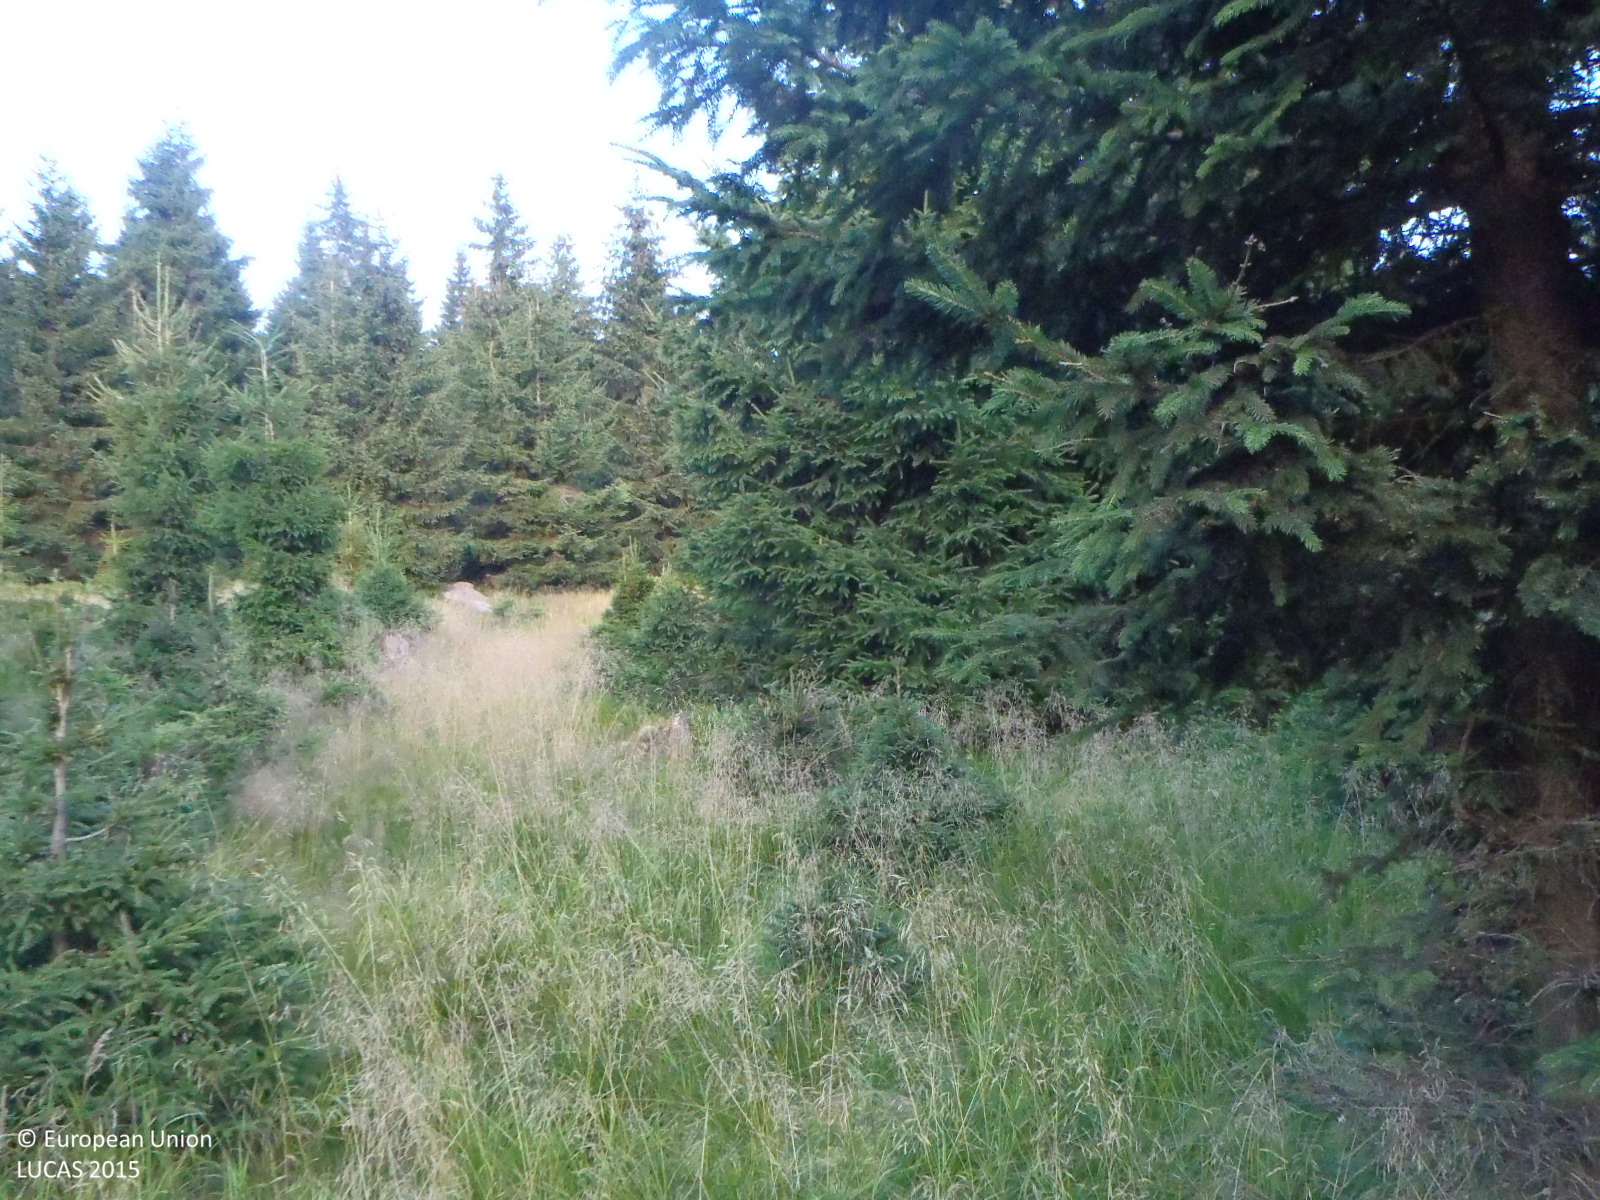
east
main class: Woodland
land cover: Spruce dominated coniferous woodland
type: hemiboreal forest and nemoral coniferous forest and mixed broadleaved-coniferous forest
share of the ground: > 75 %
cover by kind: coniferous forest trees 80 %, herbaceous plants 15 %, shrubs 5 %
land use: Forestry
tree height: > 5 m
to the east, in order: Spruce dominated coniferous woodland; Tracks; Spruce dominated coniferous woodland
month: August
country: CZ
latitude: 50.8205
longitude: 15.2414
